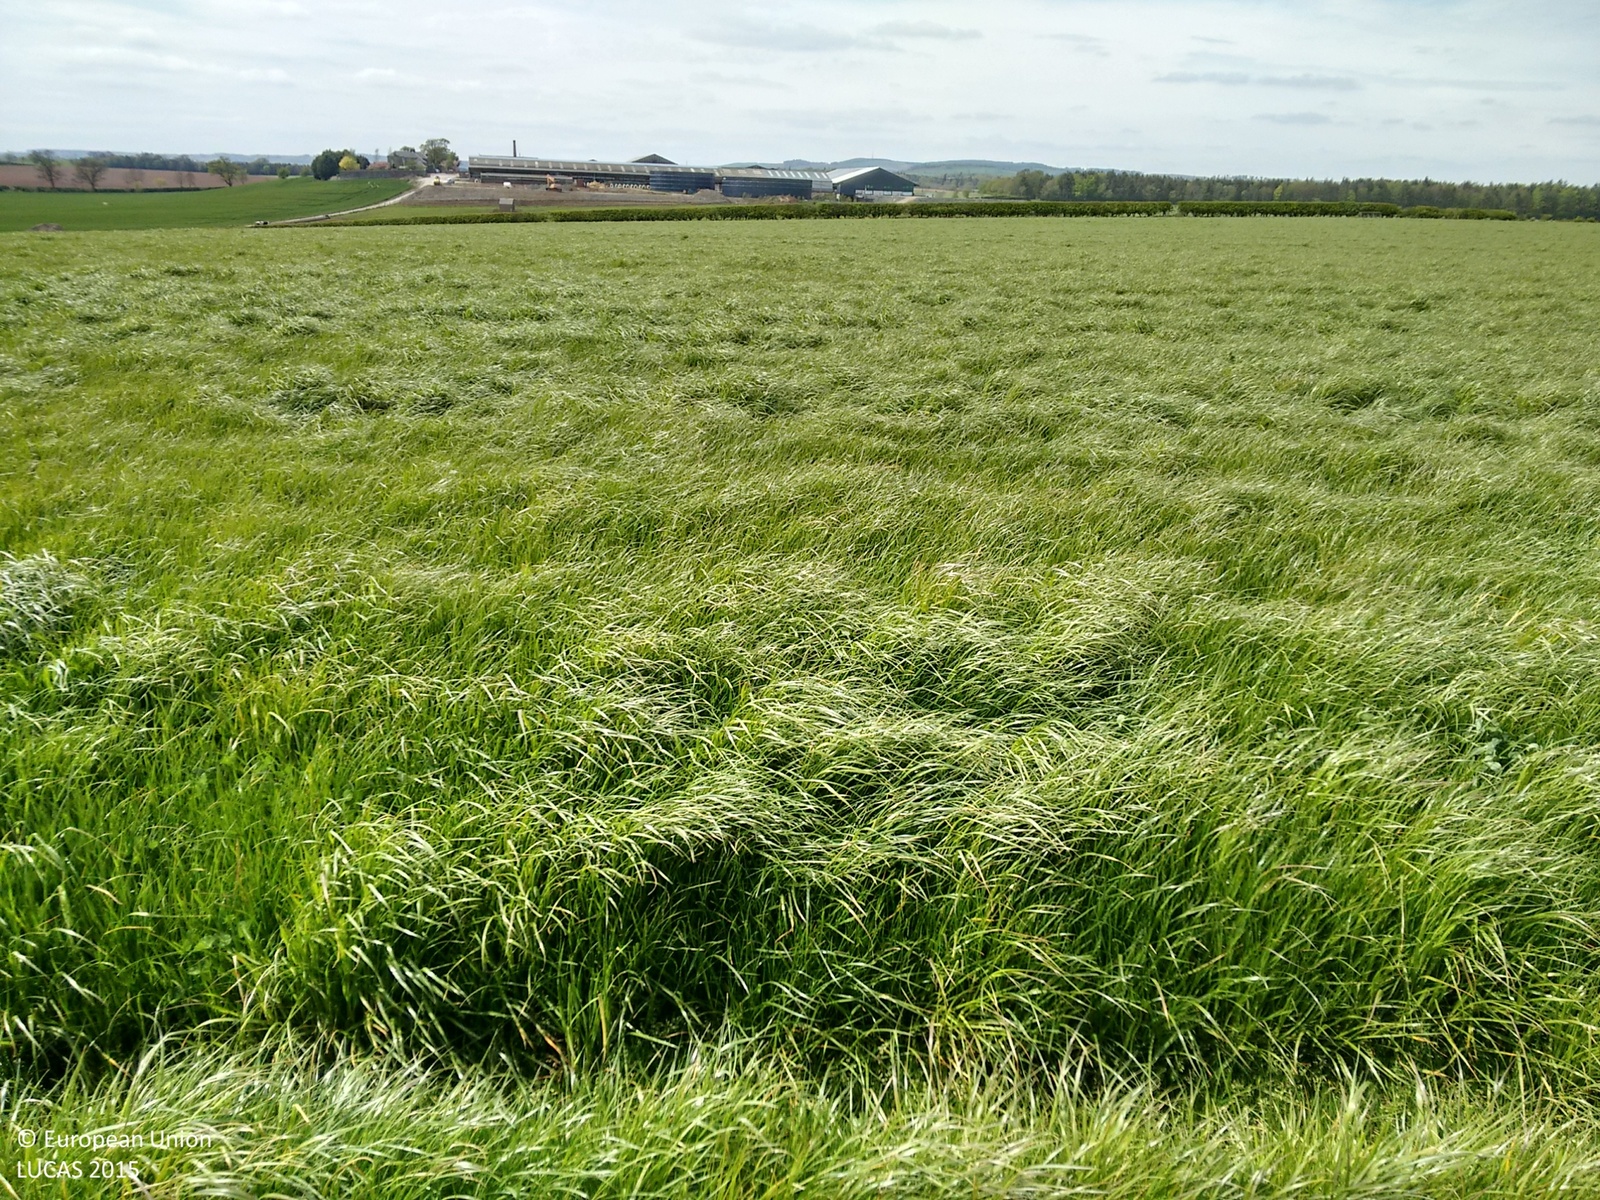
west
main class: Cropland
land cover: Barley
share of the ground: > 75 %
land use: Agriculture (excluding fallow land and kitchen gardens)
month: May
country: GB
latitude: 55.7799
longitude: -2.2533
